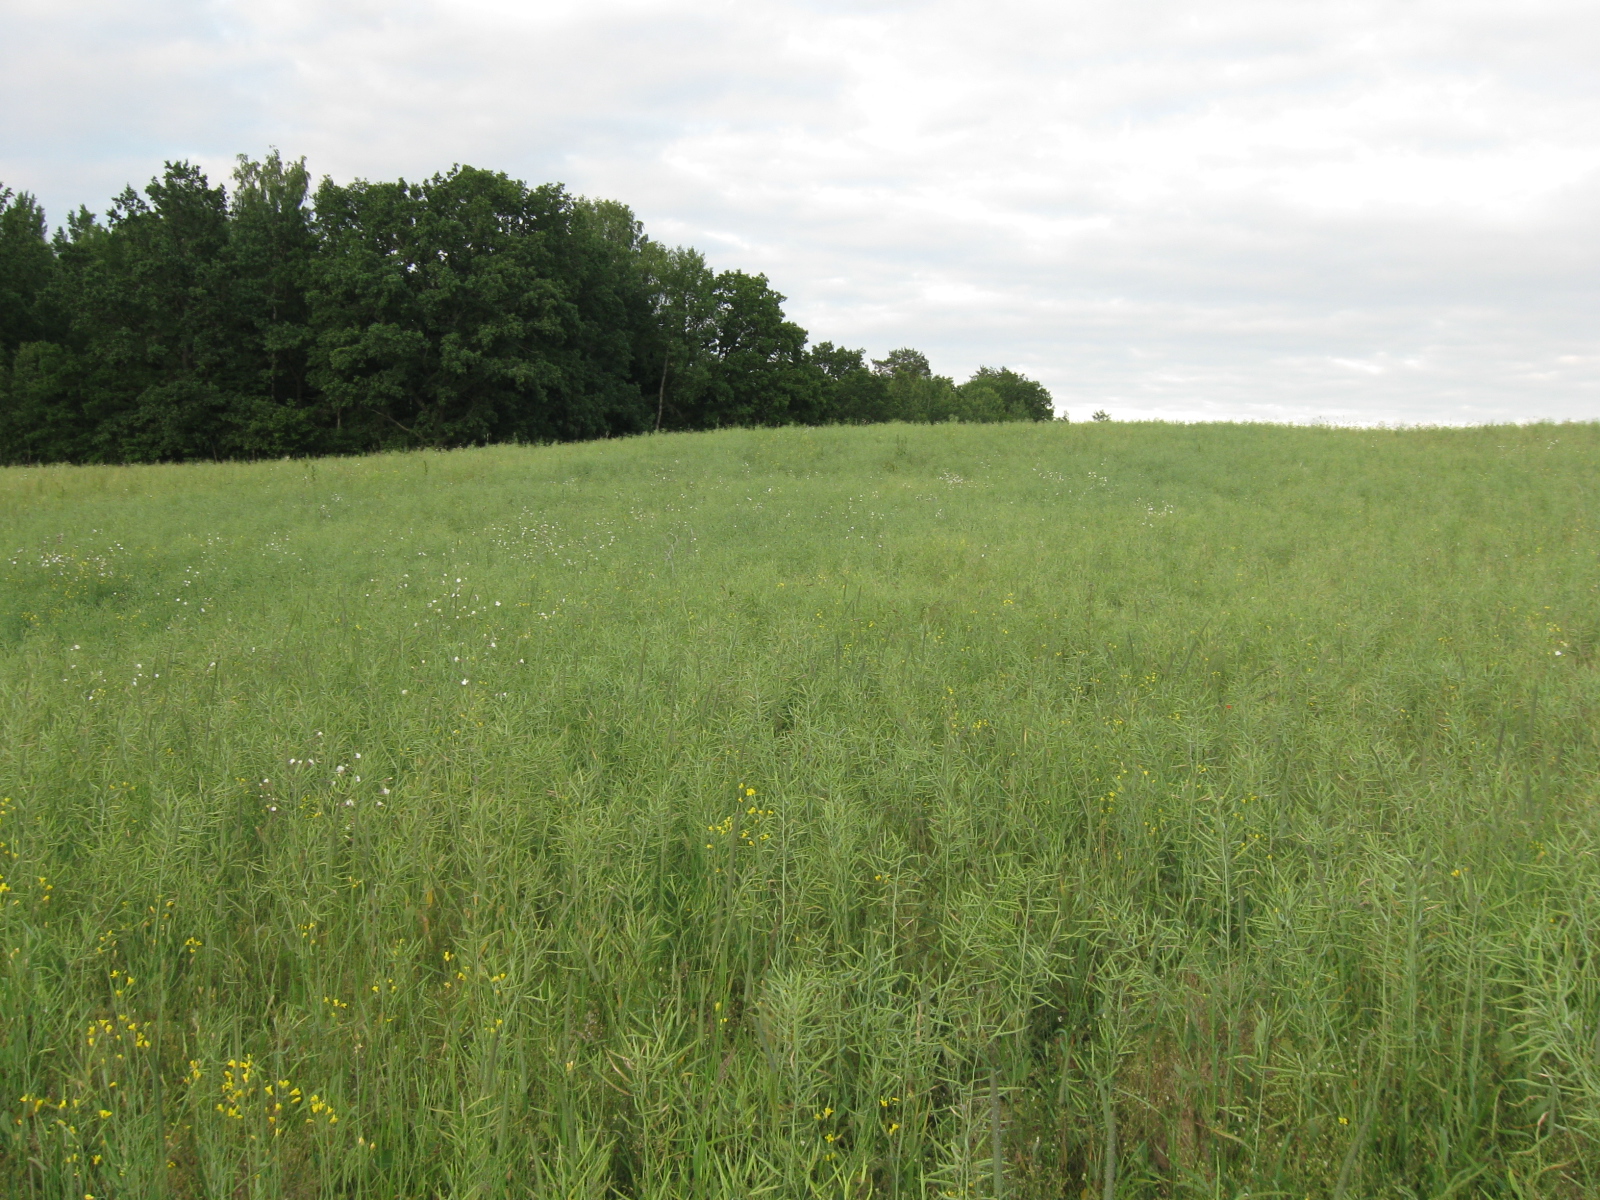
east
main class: Cropland
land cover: Rape and turnip rape
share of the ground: > 75 %
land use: Agriculture (excluding fallow land and kitchen gardens)
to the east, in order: Rape and turnip rape; Tracks; Grass margins; Broadleaved woodland; Spruce dominated mixed woodland
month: June
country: LT
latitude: 54.4123
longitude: 24.6049
